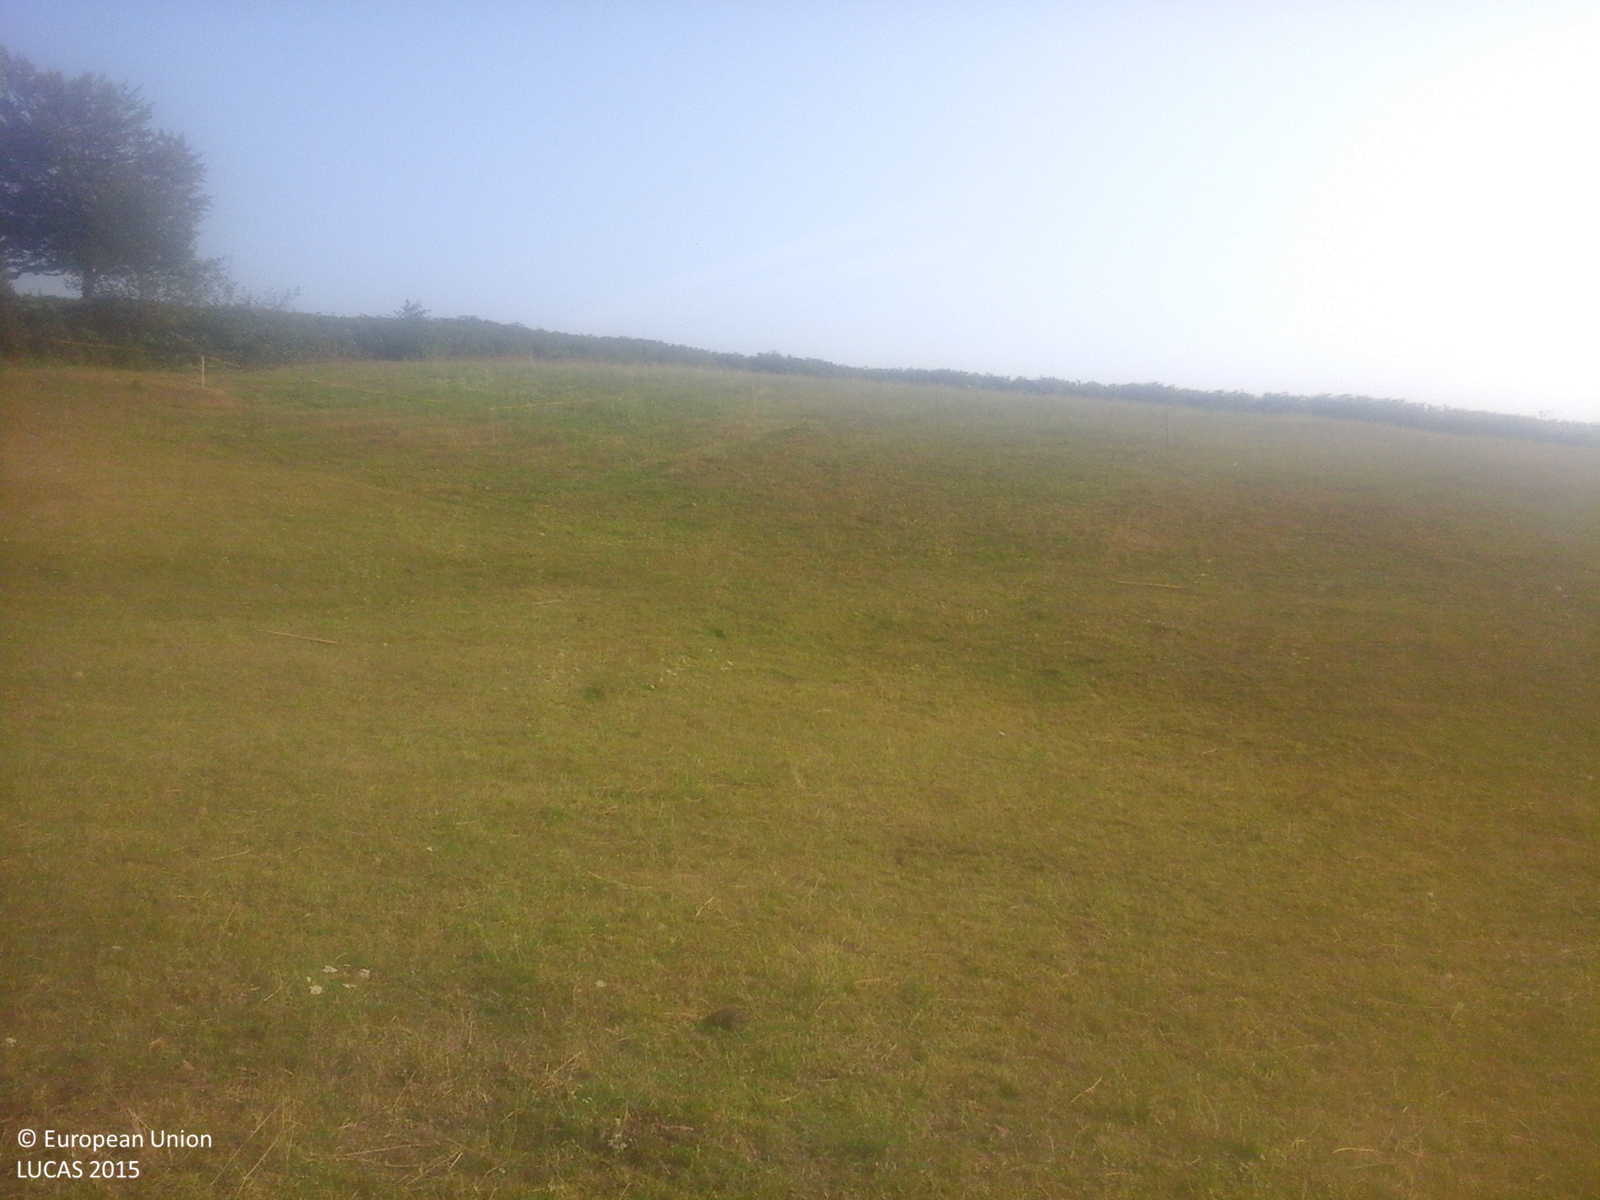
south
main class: Grassland
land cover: Grassland without tree/shrub cover
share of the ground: > 75 %
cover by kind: herbaceous plants 100 %
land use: Agriculture (excluding fallow land and kitchen gardens)
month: September
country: RO
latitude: 47.5891
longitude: 23.7896
